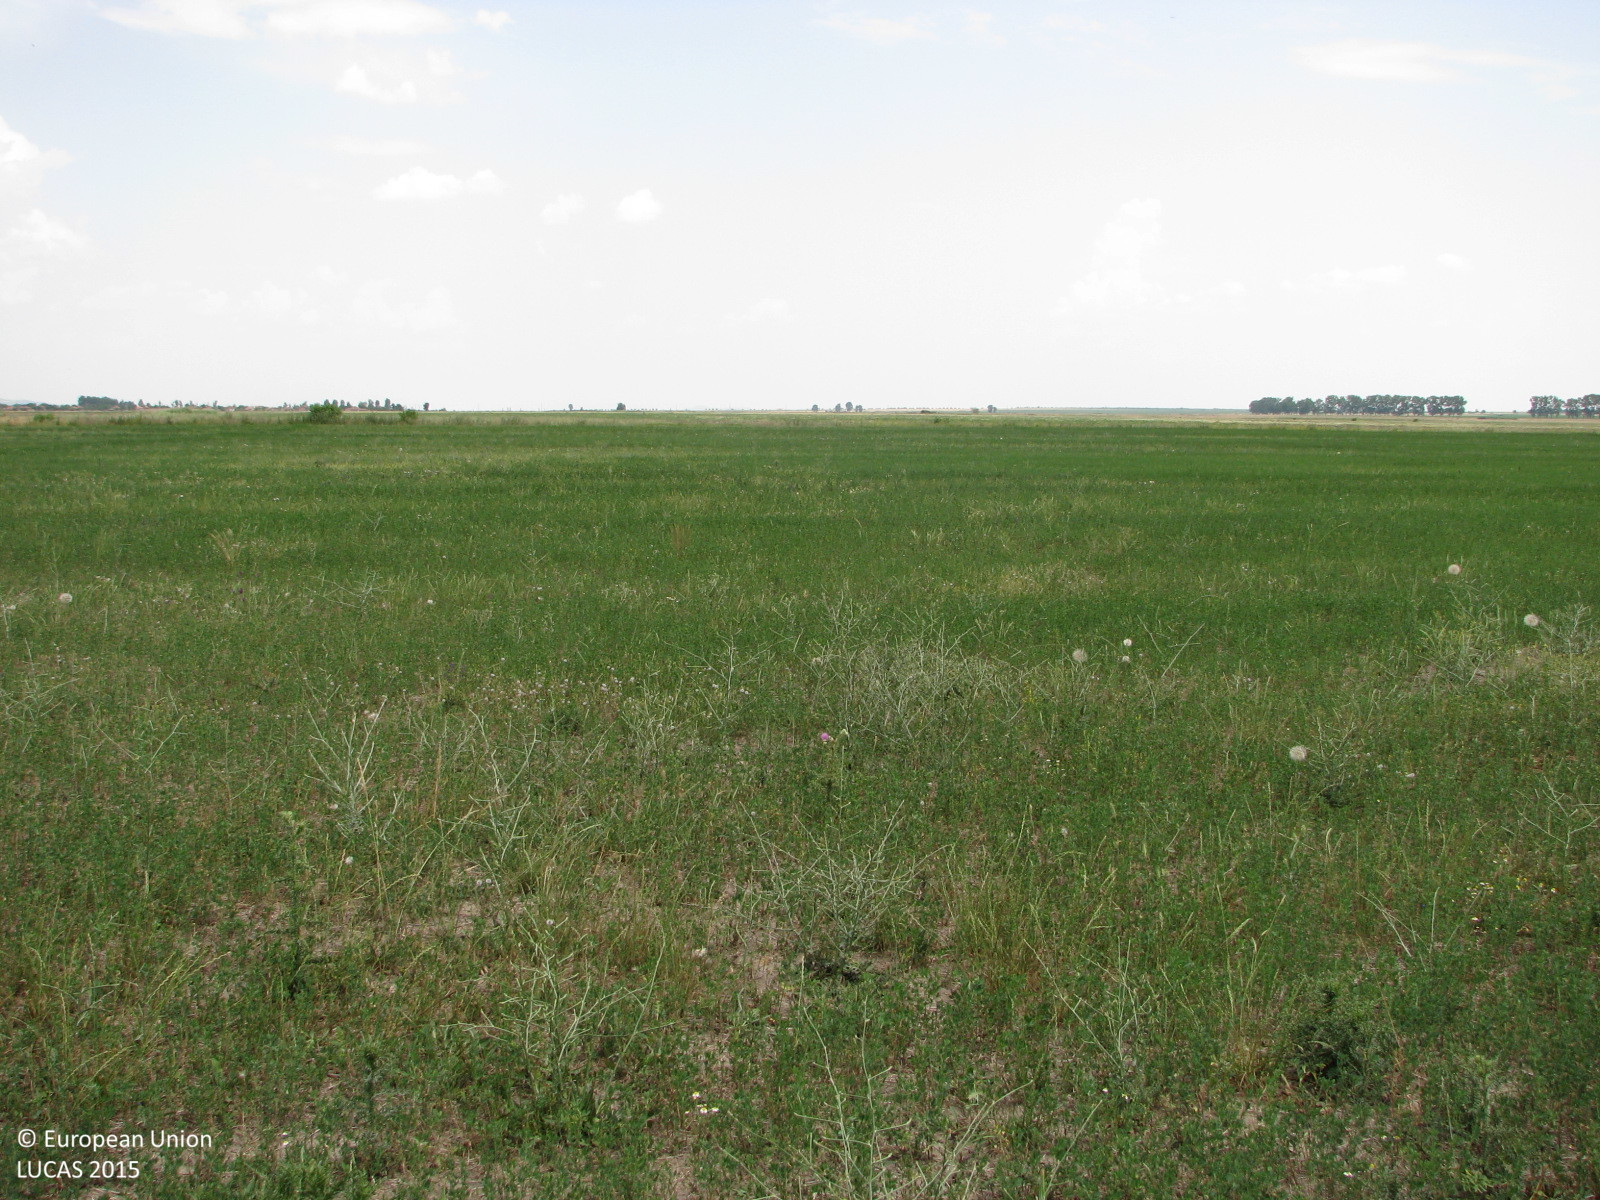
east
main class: Cropland
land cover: Lucerne
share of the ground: > 75 %
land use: Agriculture (excluding fallow land and kitchen gardens)
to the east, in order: Lucerne; Grass margins; Ditches and canals; Grass margins; Spontaneously vegetated surfaces
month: June
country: BG
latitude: 42.6254
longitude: 26.5432
